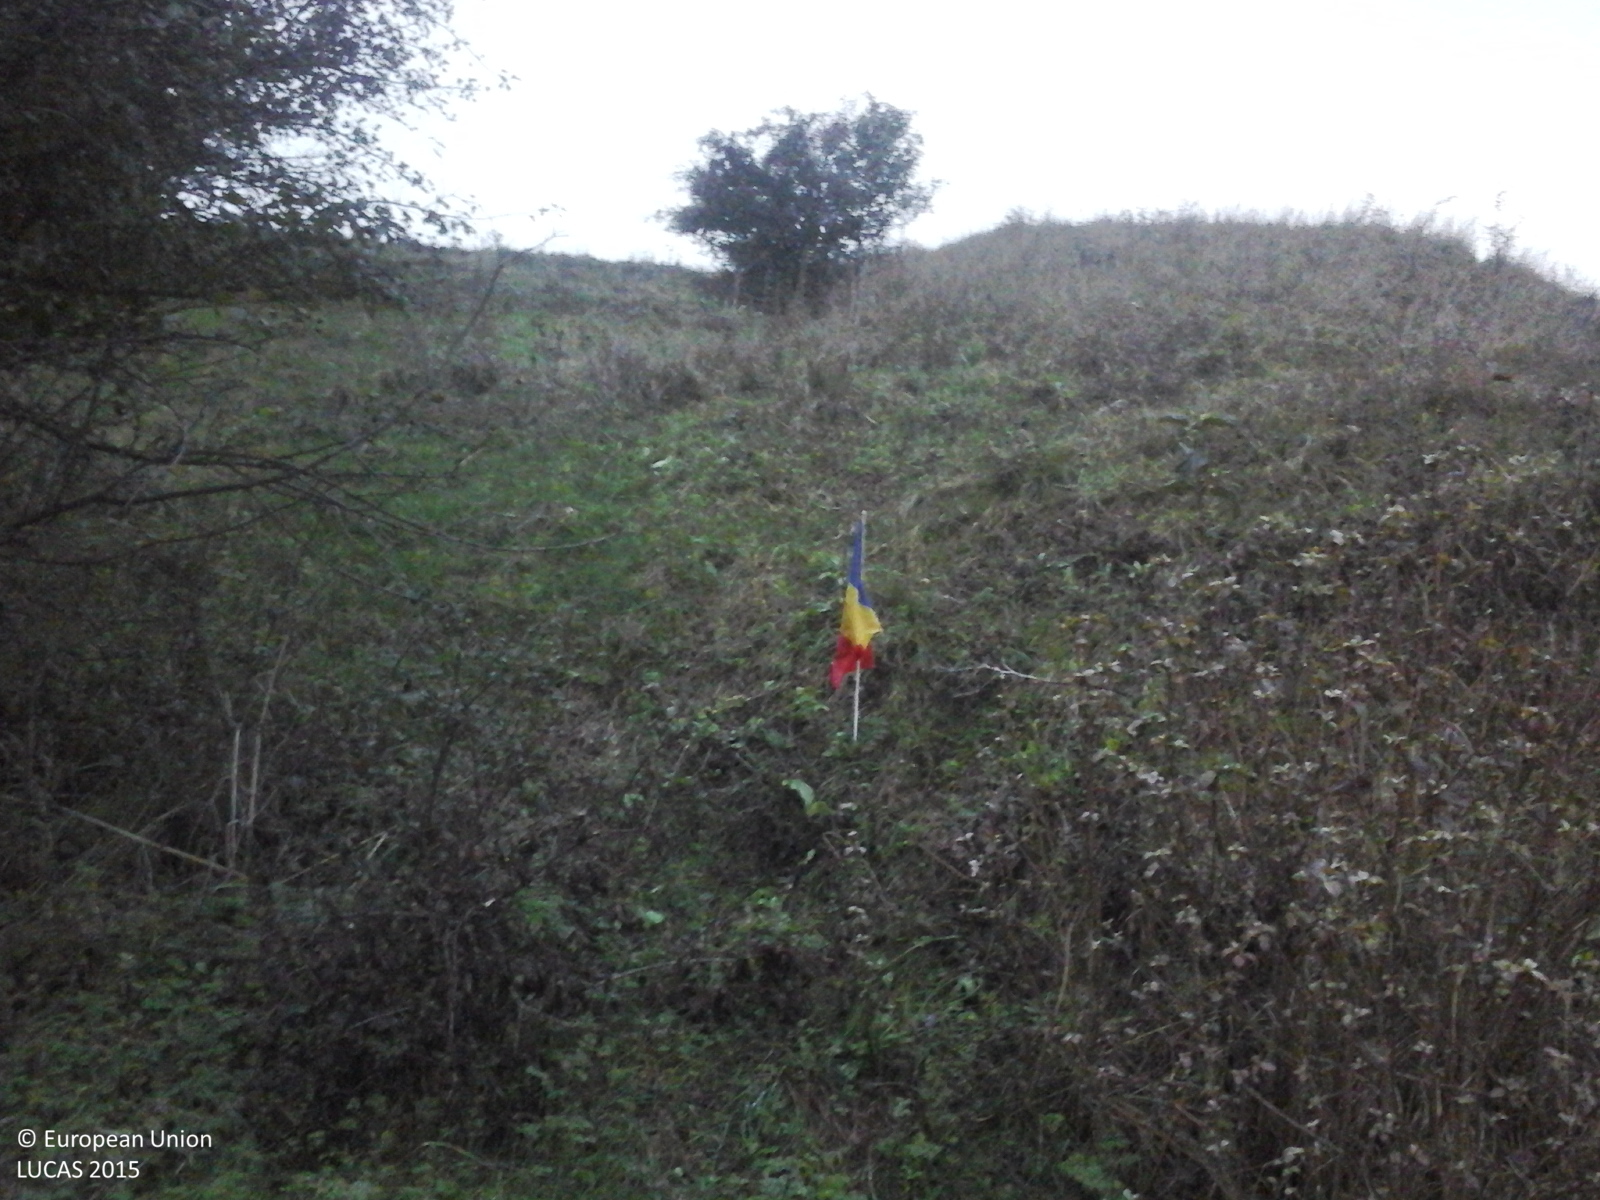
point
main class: Grassland
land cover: Grassland with sparse tree/shrub cover
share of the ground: > 75 %
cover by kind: herbaceous plants 85 %, shrubs 10 %, broadleaved forest trees 5 %
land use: Agriculture (excluding fallow land and kitchen gardens)
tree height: > 5 m
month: October
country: RO
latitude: 45.9175
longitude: 24.1422
